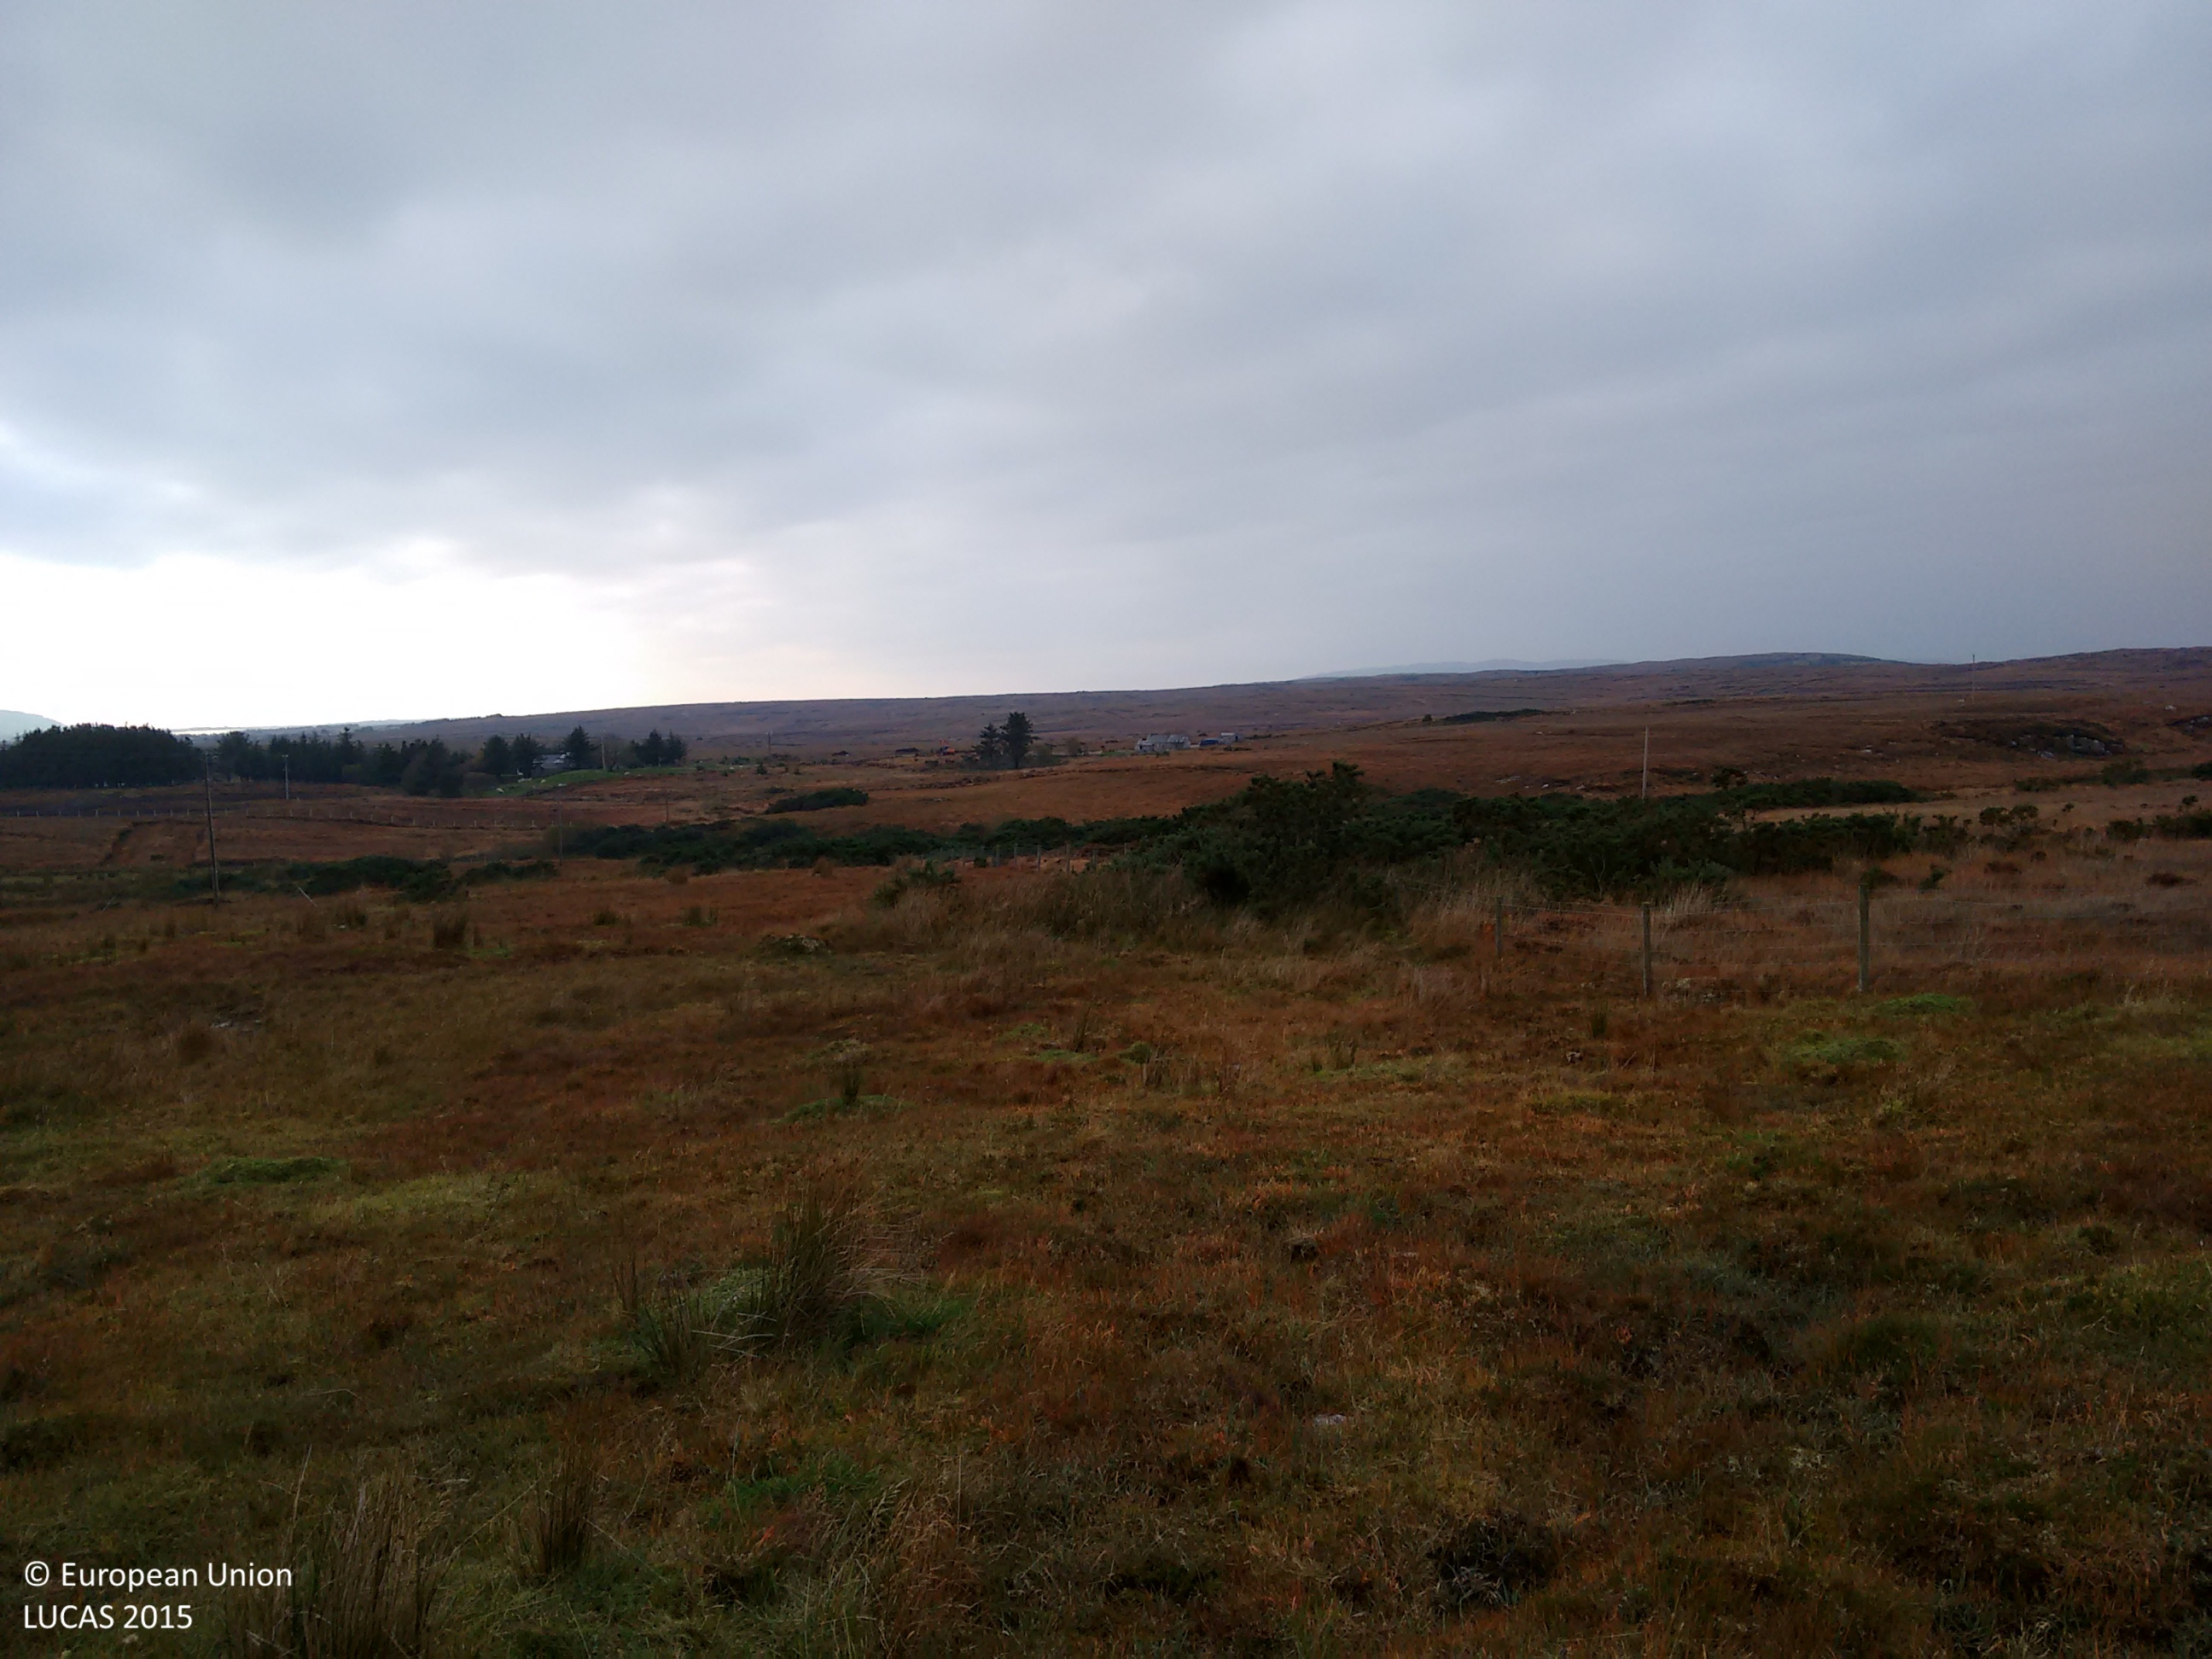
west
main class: Grassland
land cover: Grassland without tree/shrub cover
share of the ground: > 75 %
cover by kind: herbaceous plants 70 %, lichens and mosses 30 %
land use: Agriculture (excluding fallow land and kitchen gardens)
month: November
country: IE
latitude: 54.9796
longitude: -8.3237
